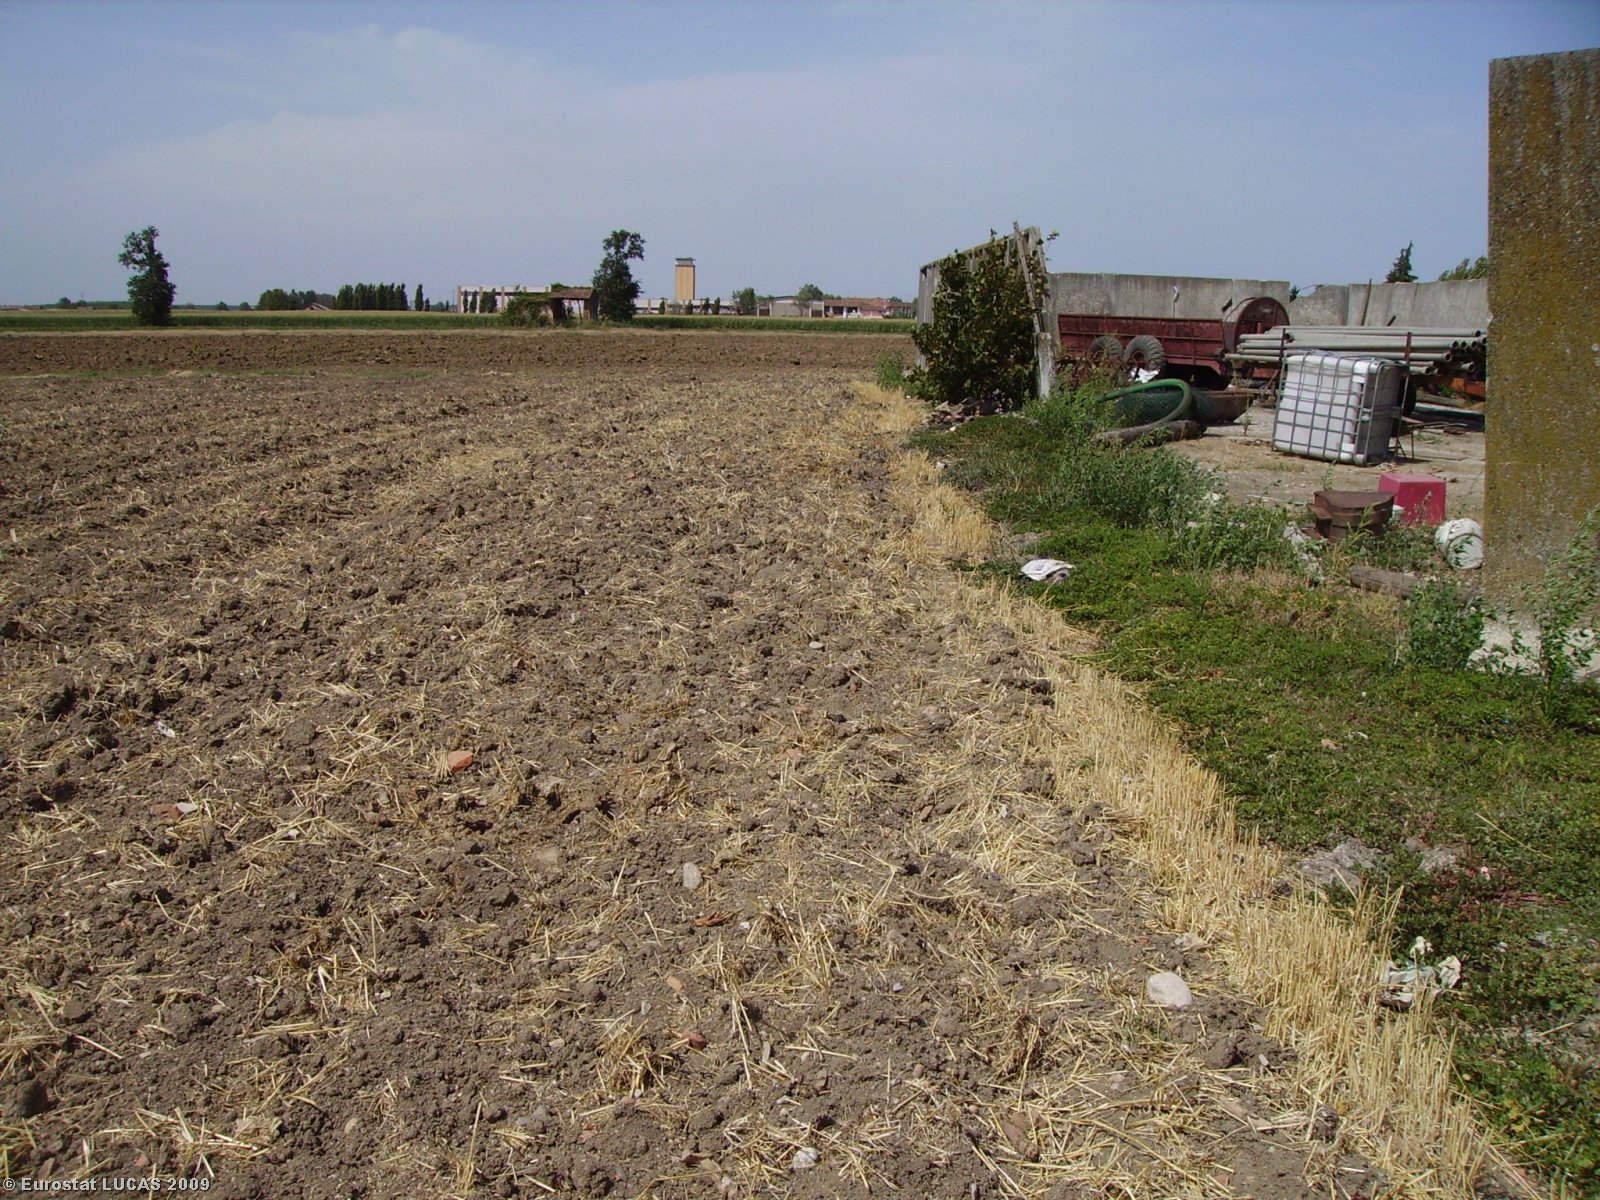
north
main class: Cropland
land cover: Common wheat
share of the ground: < 10 %
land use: Agriculture (excluding fallow land and kitchen gardens)
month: July
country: IT
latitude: 45.0874
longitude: 9.2772
